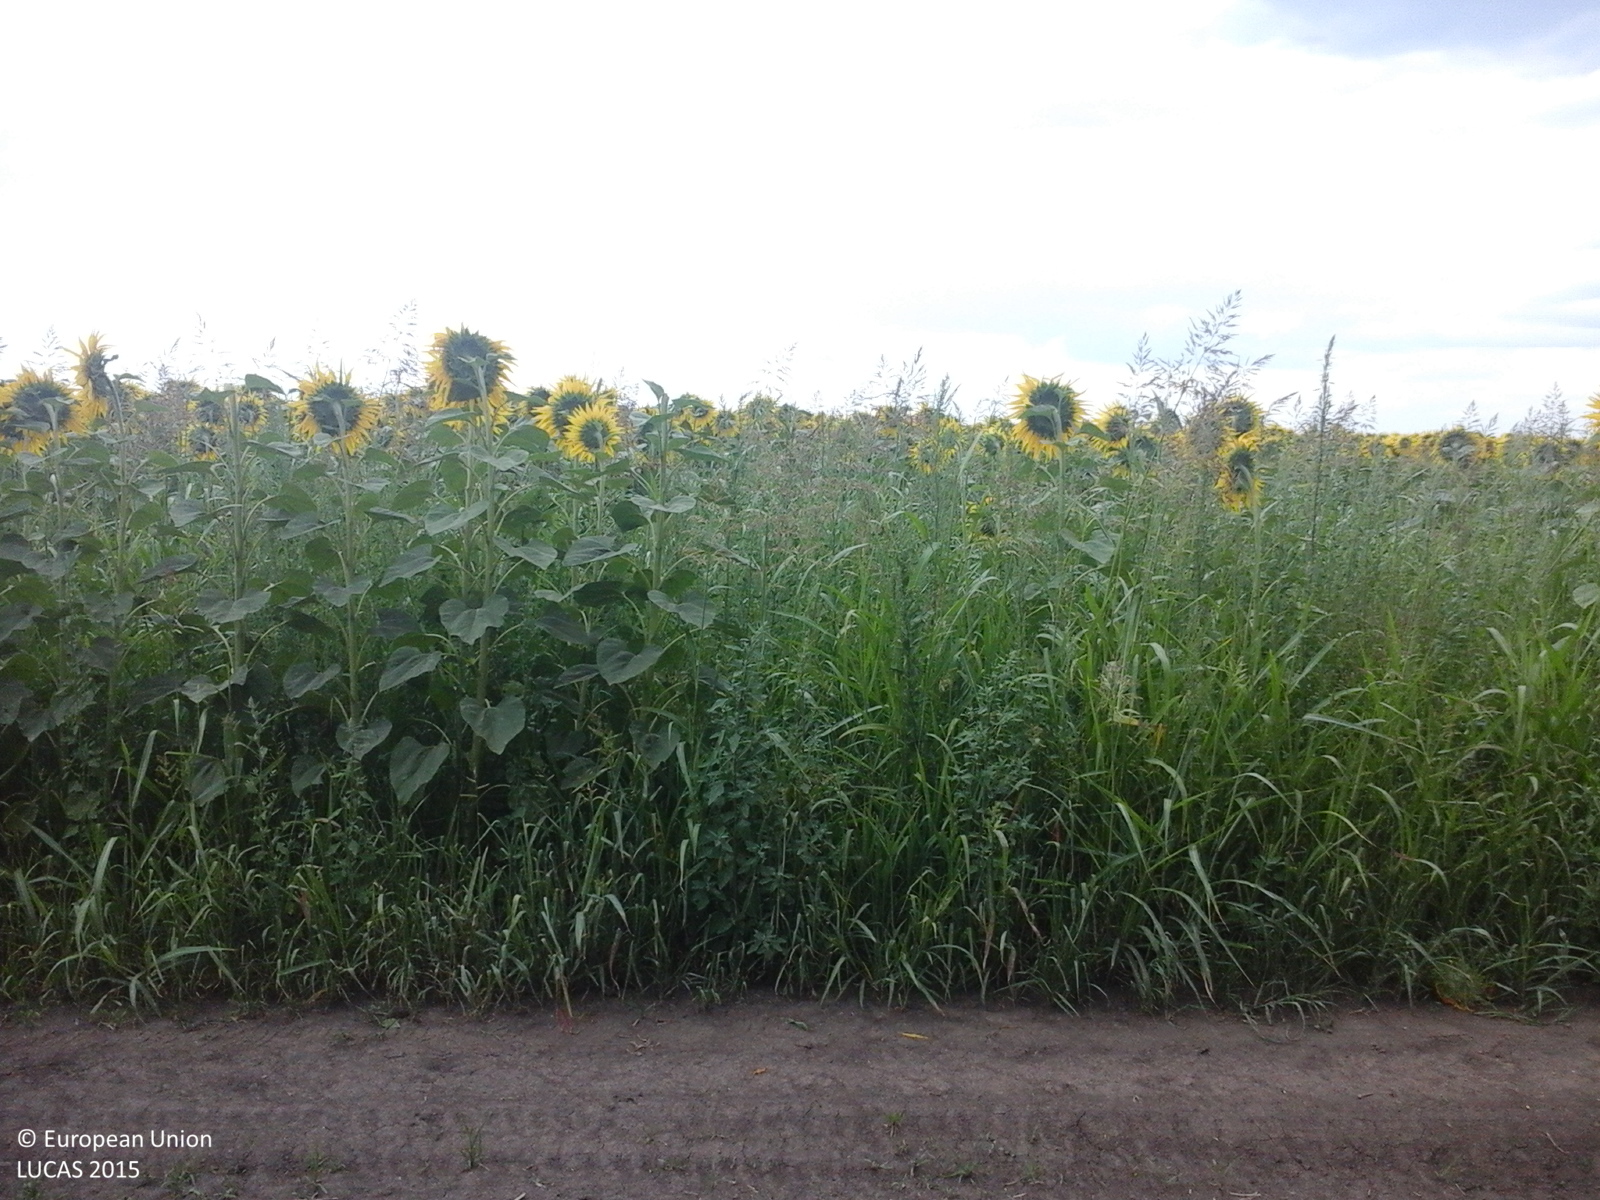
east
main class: Cropland
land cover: Sunflower
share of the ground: > 75 %
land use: Agriculture (excluding fallow land and kitchen gardens)
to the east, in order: Sunflower; Common wheat
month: July
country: RO
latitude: 43.8012
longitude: 25.2559
